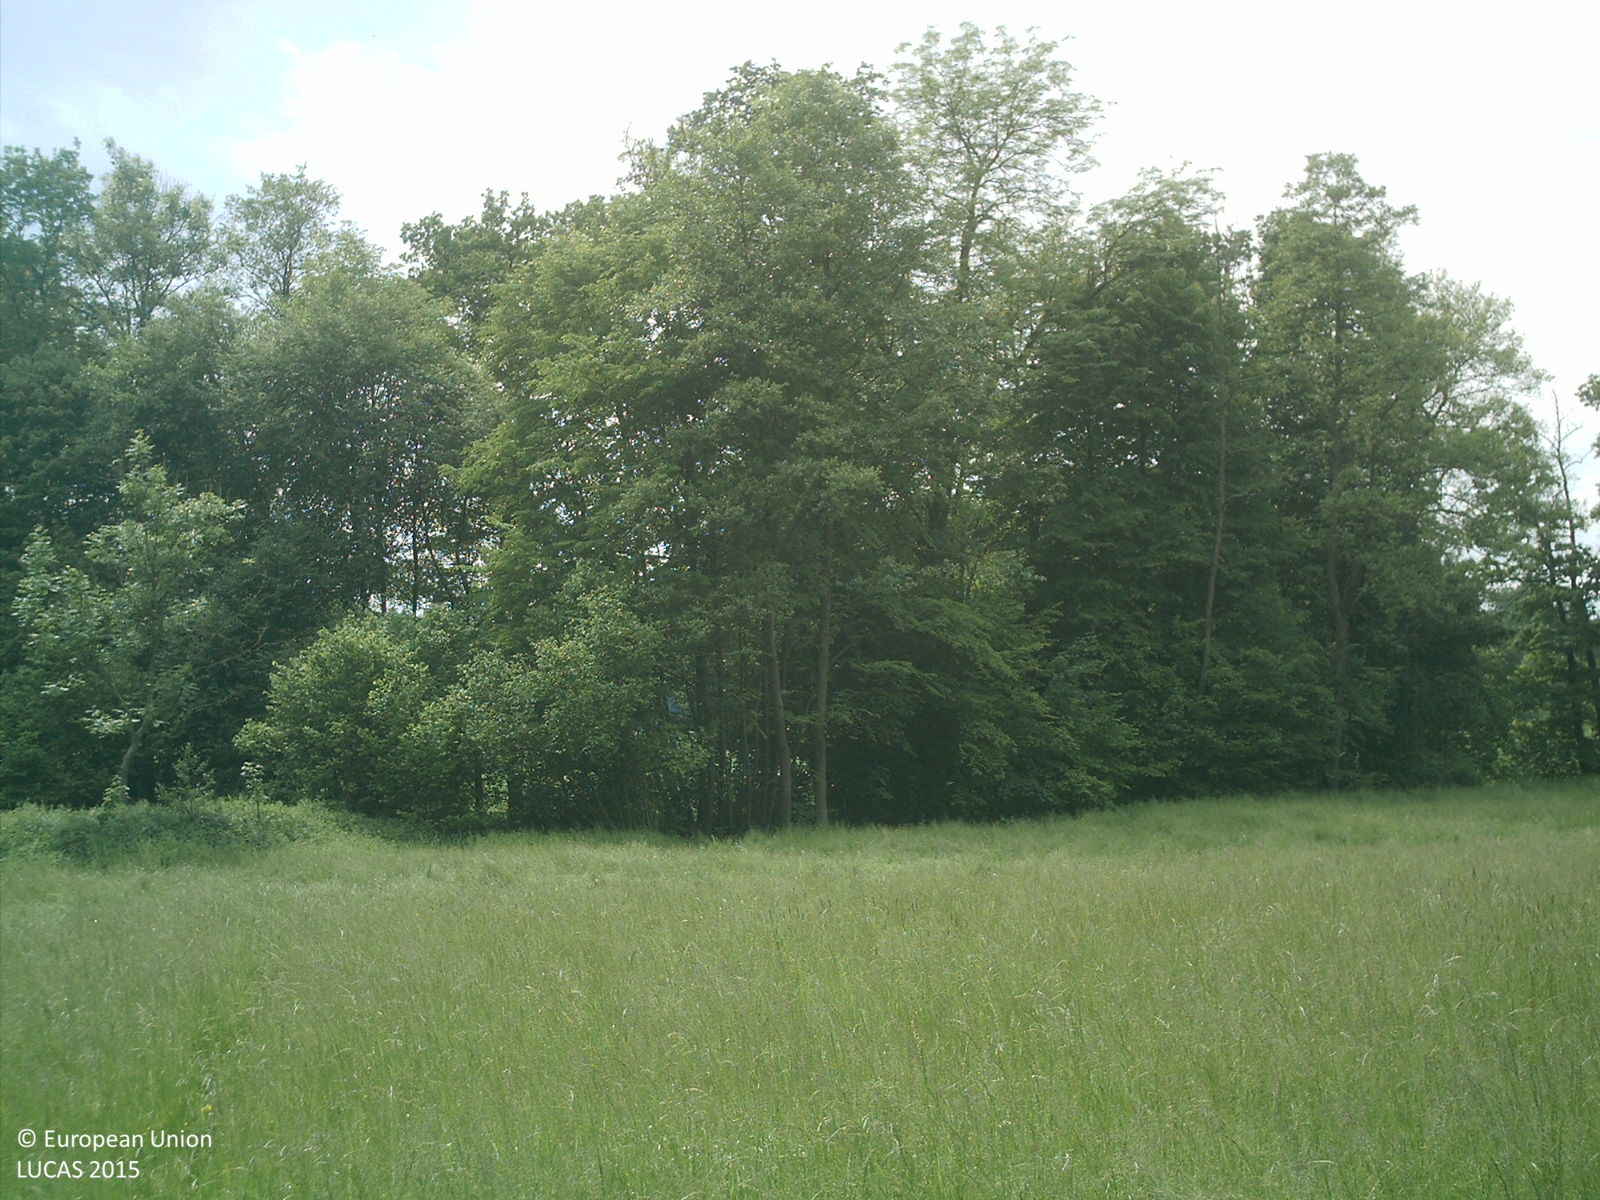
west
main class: Grassland
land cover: Grassland without tree/shrub cover
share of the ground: > 75 %
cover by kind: herbaceous plants 100 %
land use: Agriculture (excluding fallow land and kitchen gardens)
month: May
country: AT
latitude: 48.1064
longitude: 14.2303
